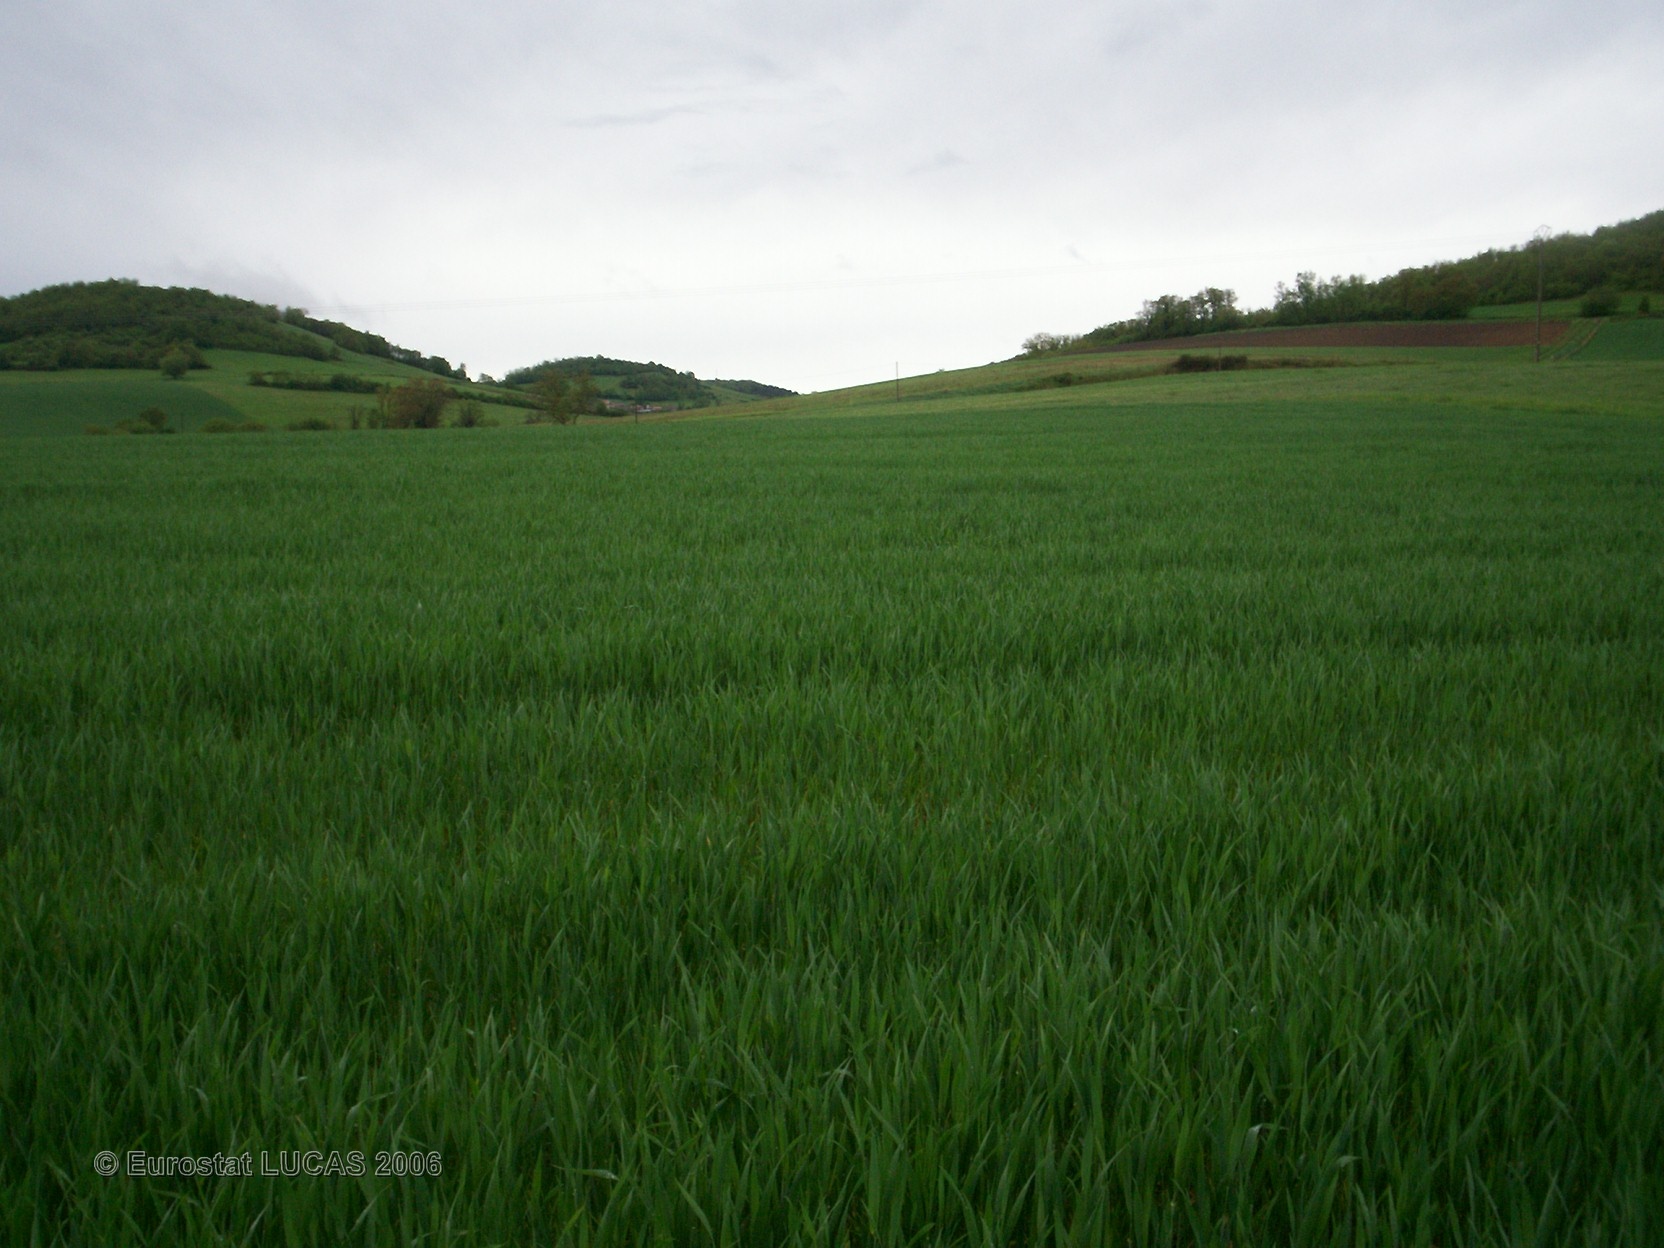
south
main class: Cropland
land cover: Common wheat
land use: Agriculture (excluding fallow land and kitchen gardens)
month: May
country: FR
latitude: 45.4143
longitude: 3.2417
